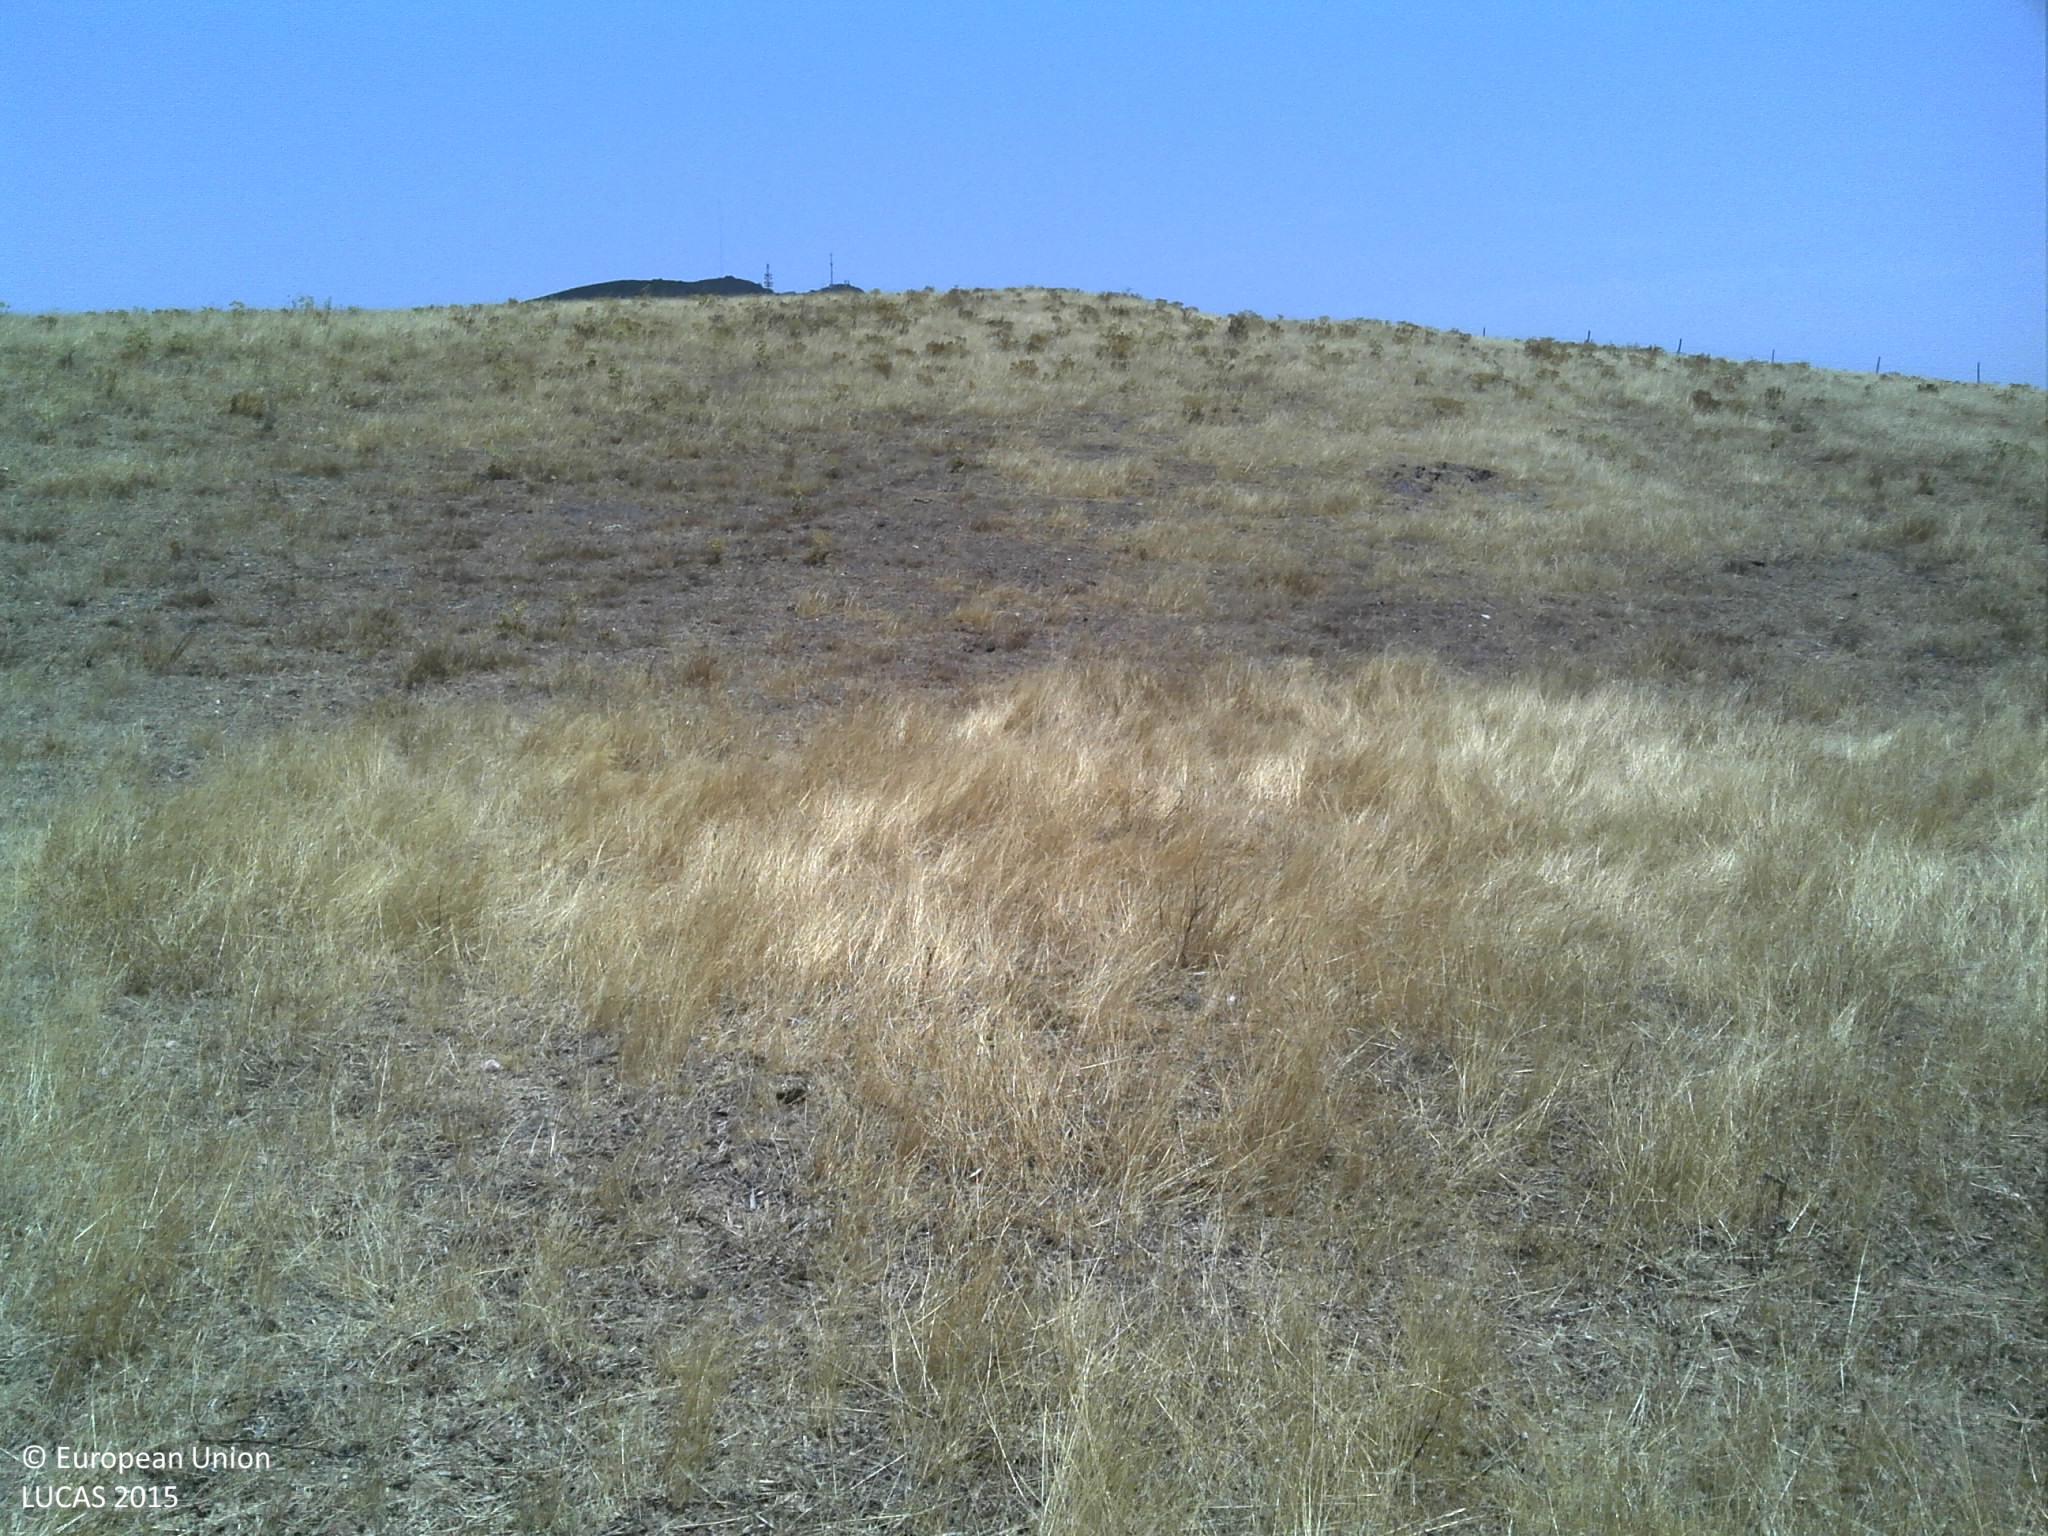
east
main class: Grassland
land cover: Grassland without tree/shrub cover
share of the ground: 10 - 25 %
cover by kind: unconsolidated bare surface 75 %, herbaceous plants 25 %
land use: Agriculture (excluding fallow land and kitchen gardens)
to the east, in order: Grassland without tree/shrub cover; Other structural elements; Grass margins; Fences; Grass margins; Other structural elements; Common wheat; Shrubland without tree cover
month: July
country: PT
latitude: 37.7018
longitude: -7.7929
